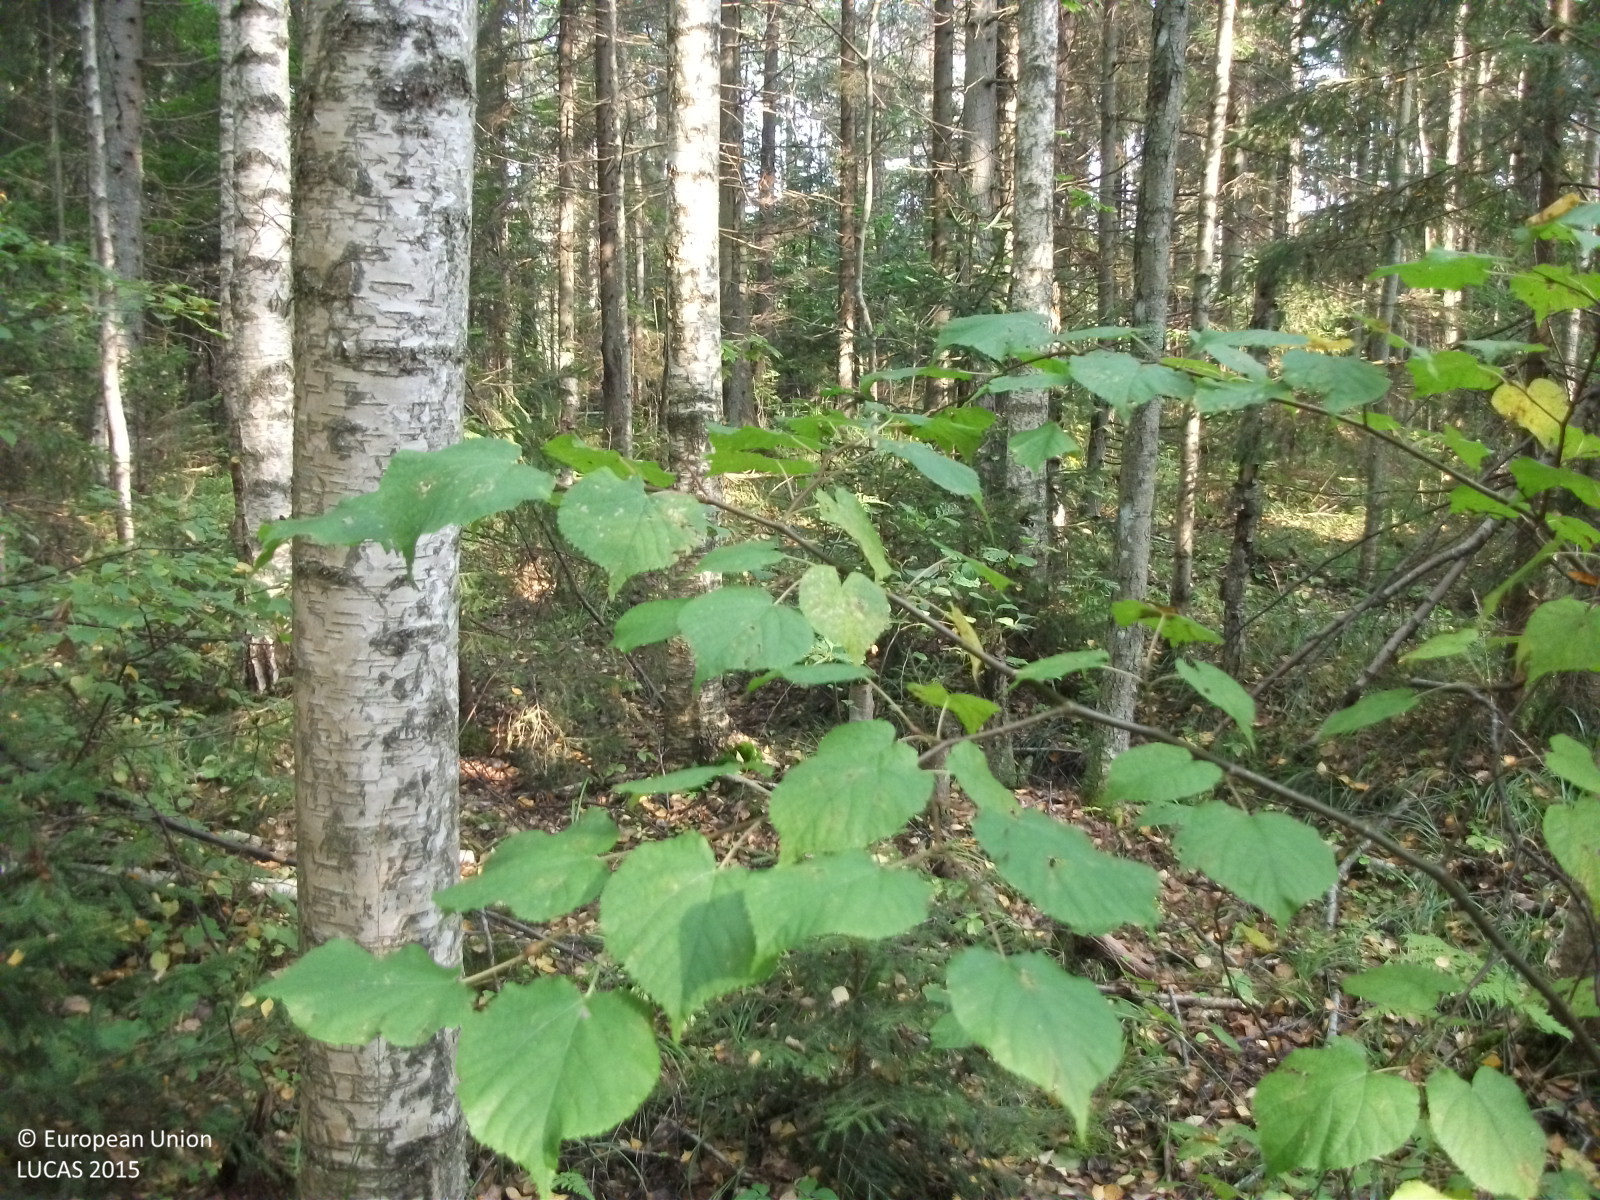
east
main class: Woodland
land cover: Spruce dominated mixed woodland
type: hemiboreal forest and nemoral coniferous forest and mixed broadleaved-coniferous forest
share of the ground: > 75 %
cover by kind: coniferous forest trees 50 %, broadleaved forest trees 30 %, herbaceous plants 10 %, shrubs 5 %, unconsolidated bare surface 5 %
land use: Forestry
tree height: > 5 m
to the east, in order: Spruce dominated mixed woodland; Broadleaved woodland; Shrubland with sparse tree cover; Ditches and canals; Shruby margins; Tracks; Spruce dominated mixed woodland; Spruce dominated coniferous woodland
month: September
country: LV
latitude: 57.8105
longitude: 24.5132
